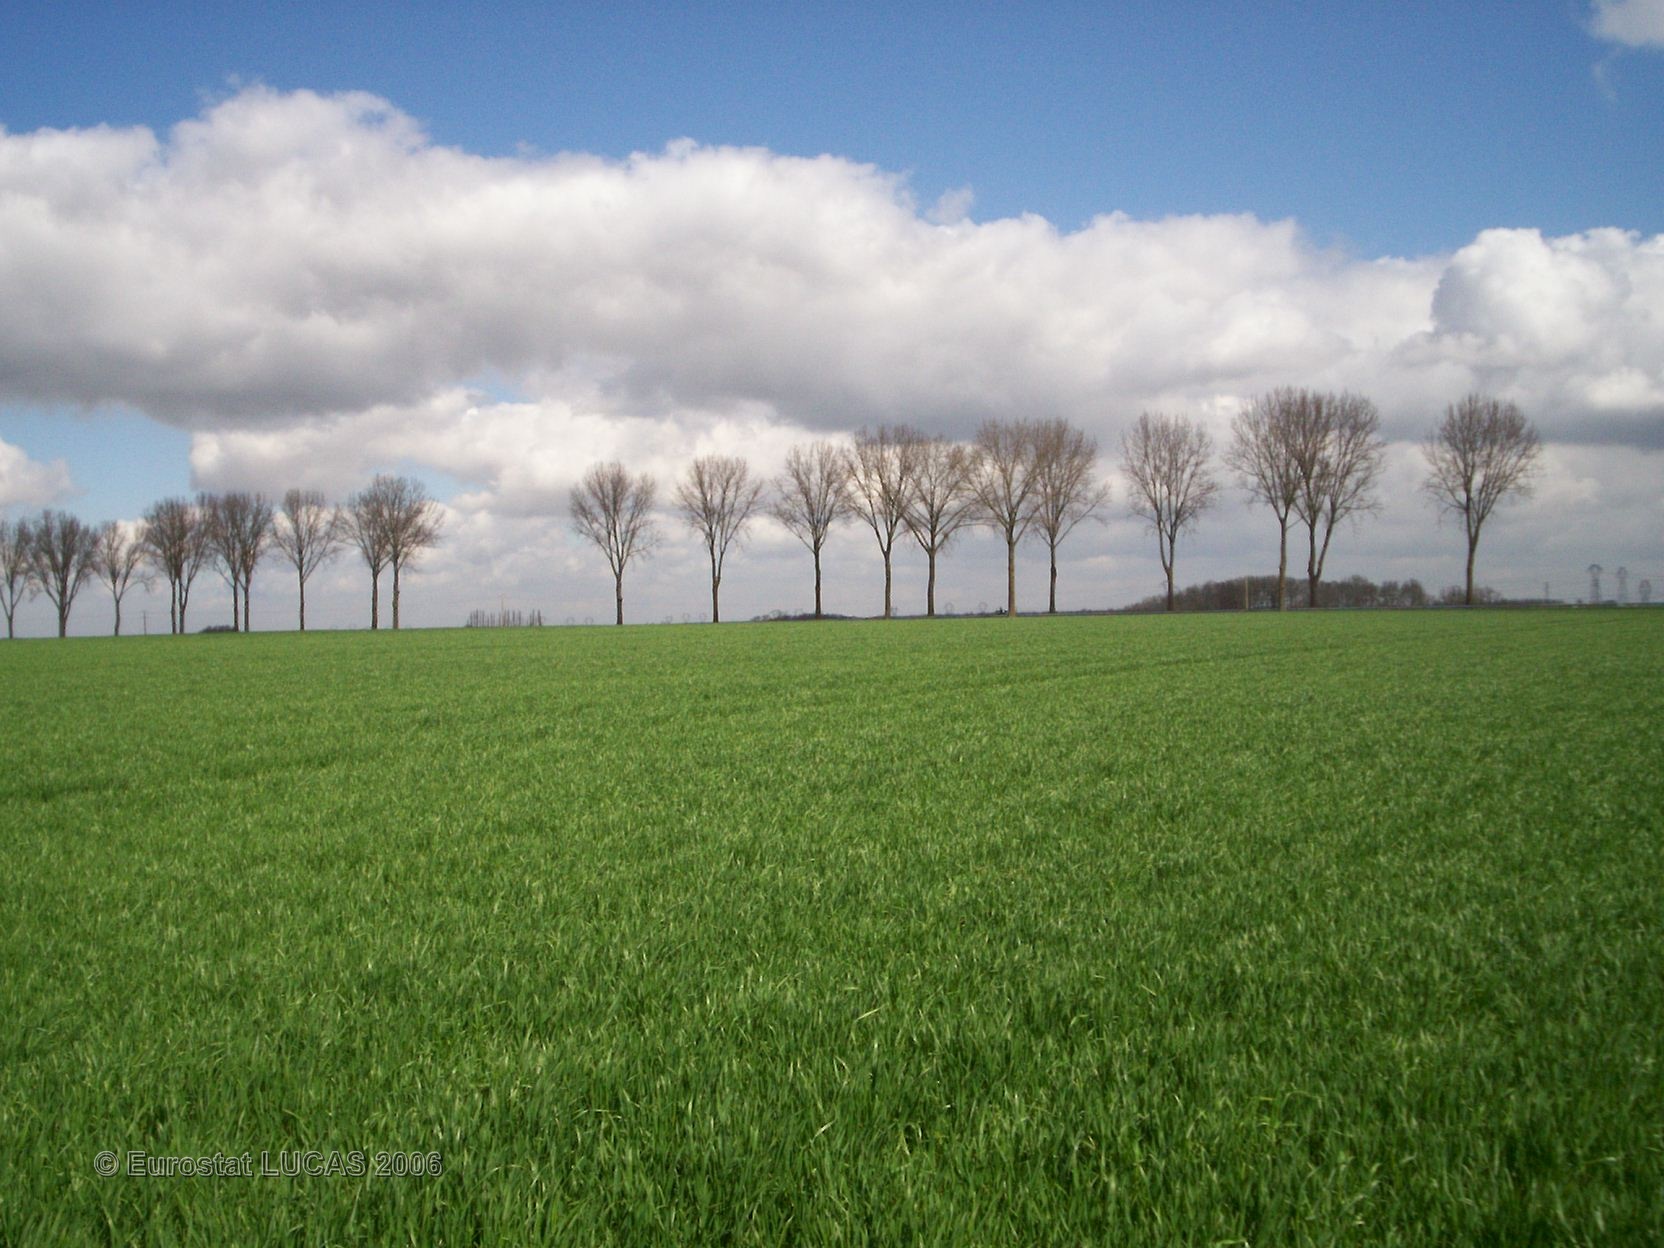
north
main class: Cropland
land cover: Common wheat
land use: Agriculture (excluding fallow land and kitchen gardens)
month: April
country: FR
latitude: 48.4941
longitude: 2.8054
